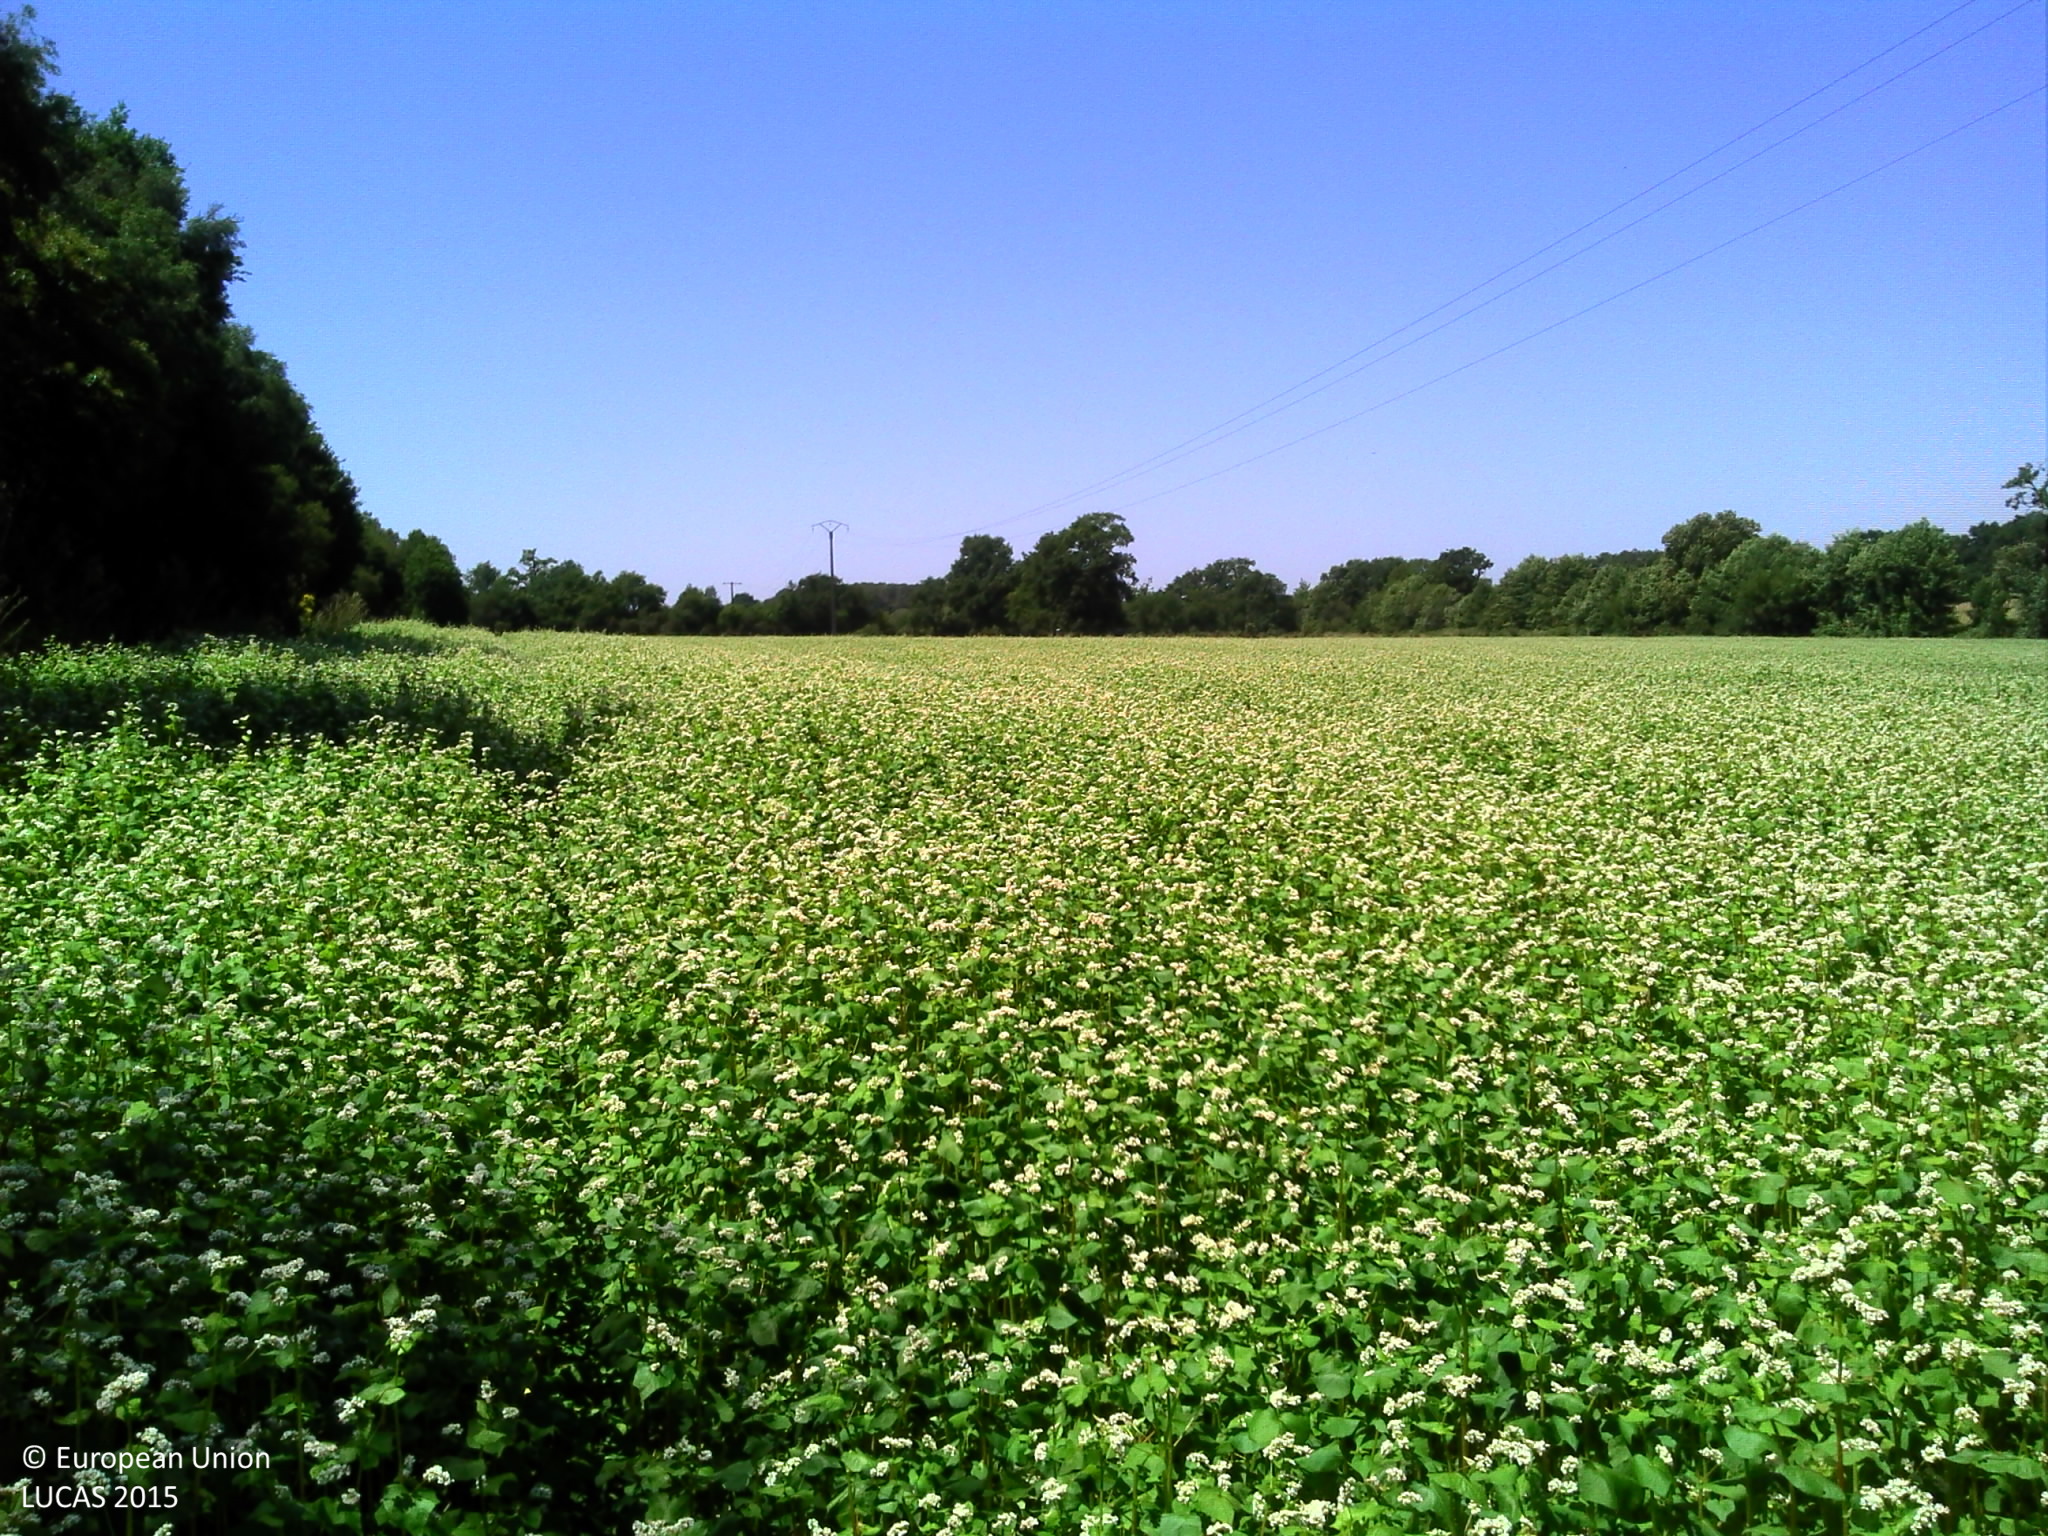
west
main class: Cropland
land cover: Other cereals
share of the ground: > 75 %
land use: Agriculture (excluding fallow land and kitchen gardens)
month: July
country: FR
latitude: 47.6038
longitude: -1.9812
